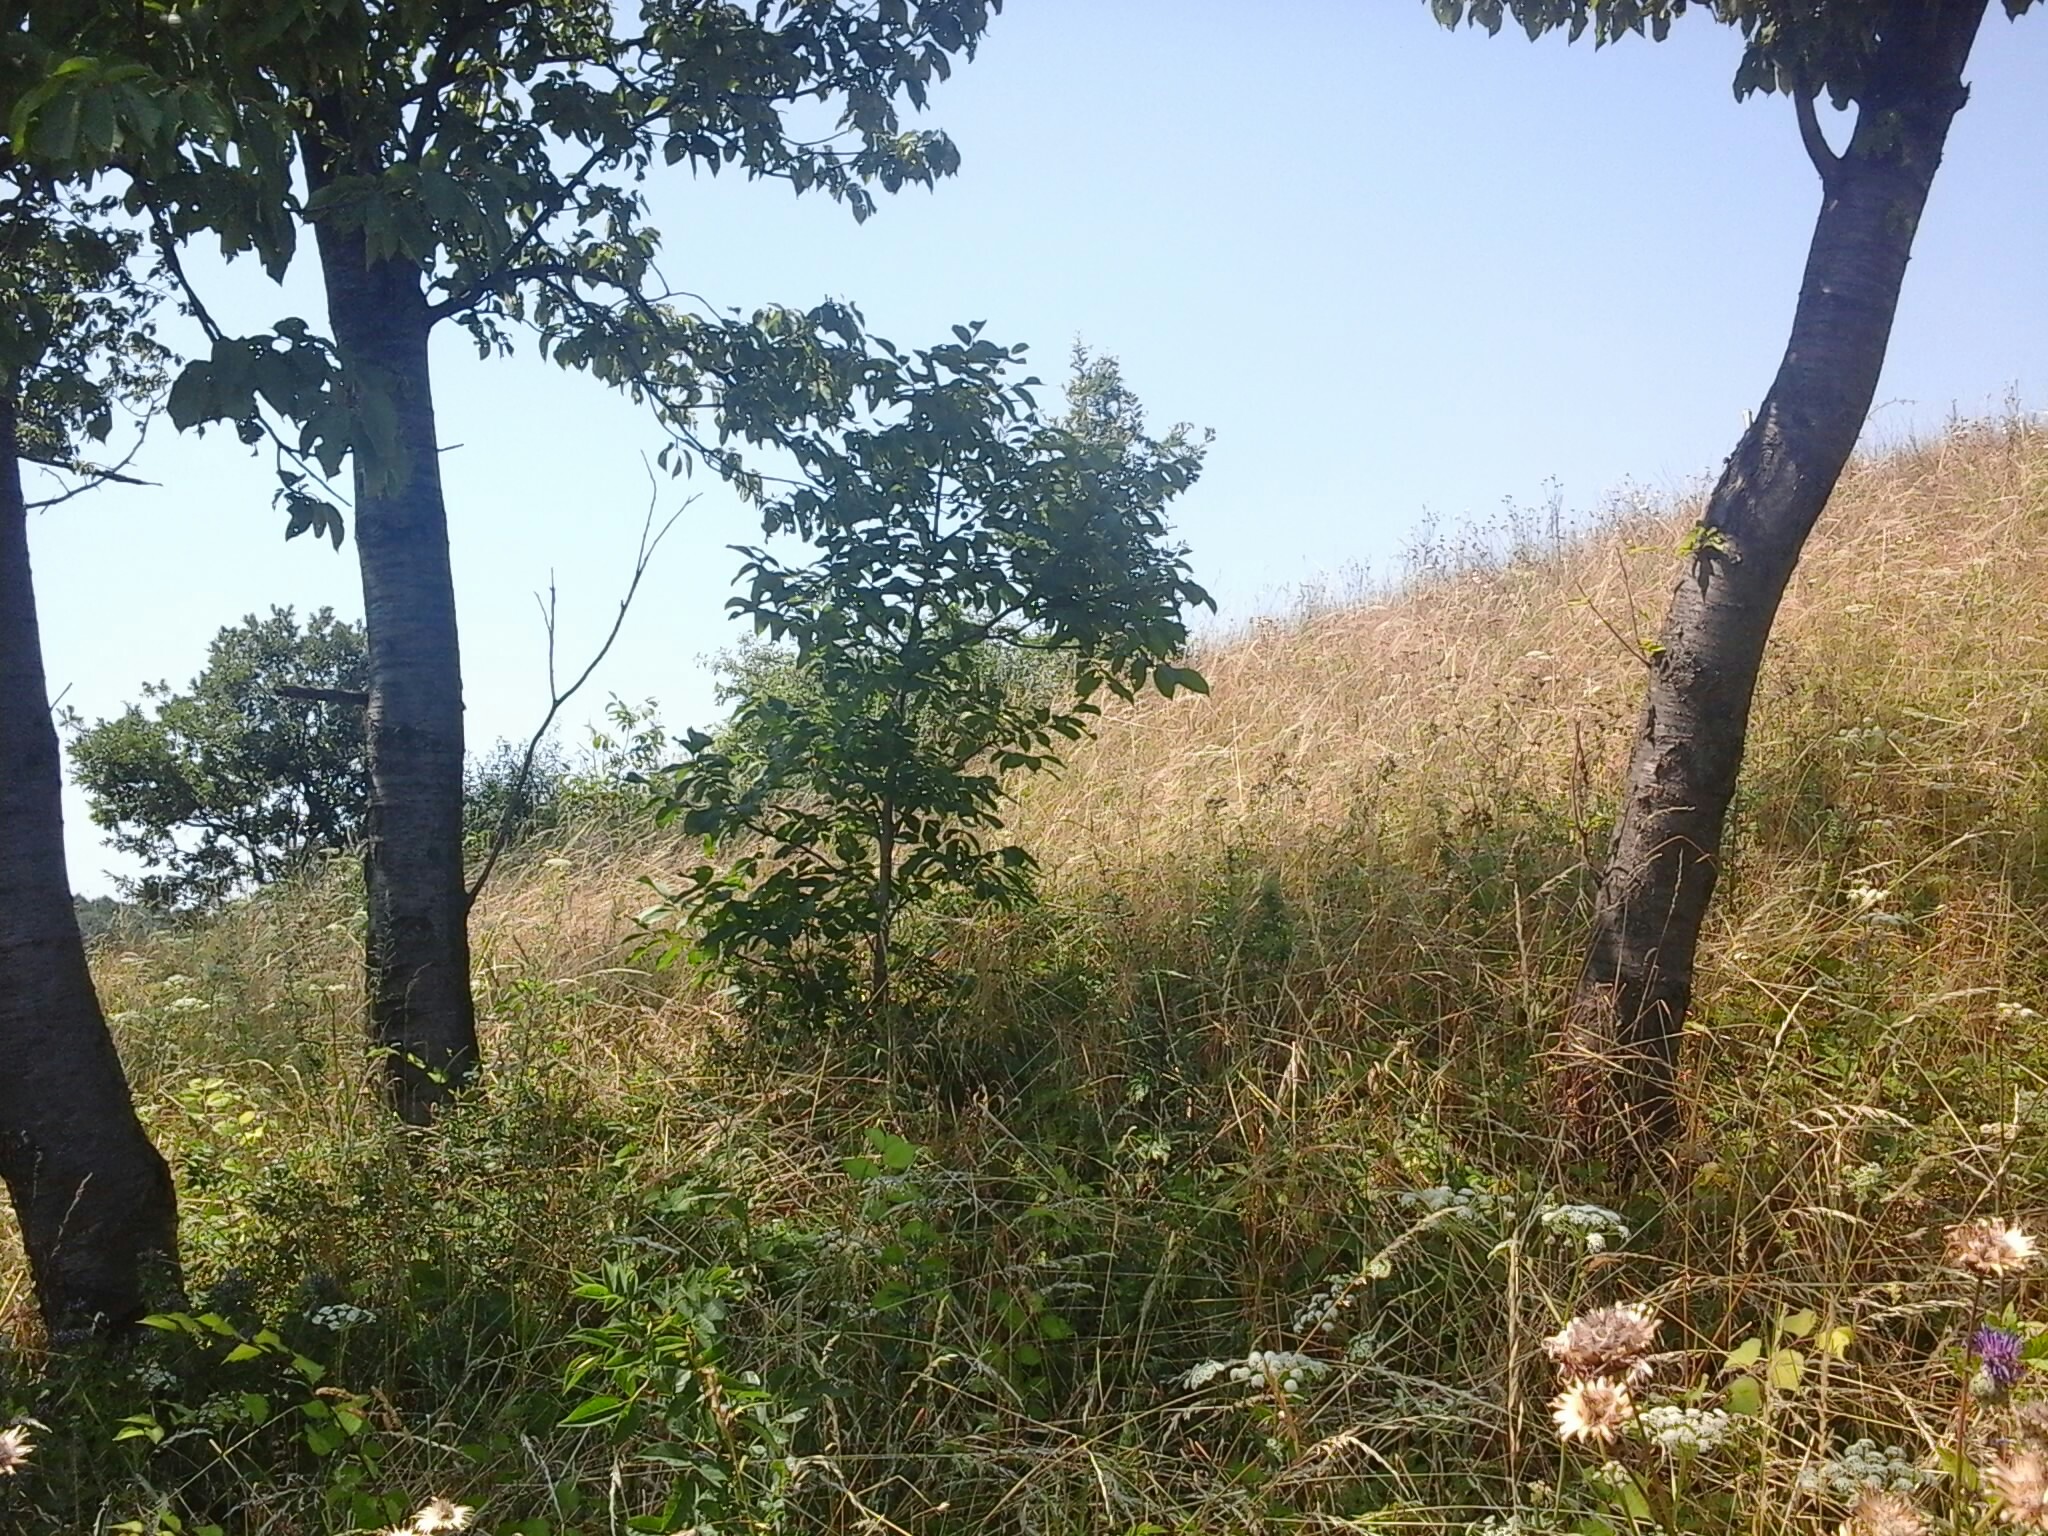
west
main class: Grassland
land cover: Grassland with sparse tree/shrub cover
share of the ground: > 75 %
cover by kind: herbaceous plants 85 %, shrubs 10 %, broadleaved forest trees 5 %
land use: Fallow land
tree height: > 5 m
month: August
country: HU
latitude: 47.4080
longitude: 18.0015
